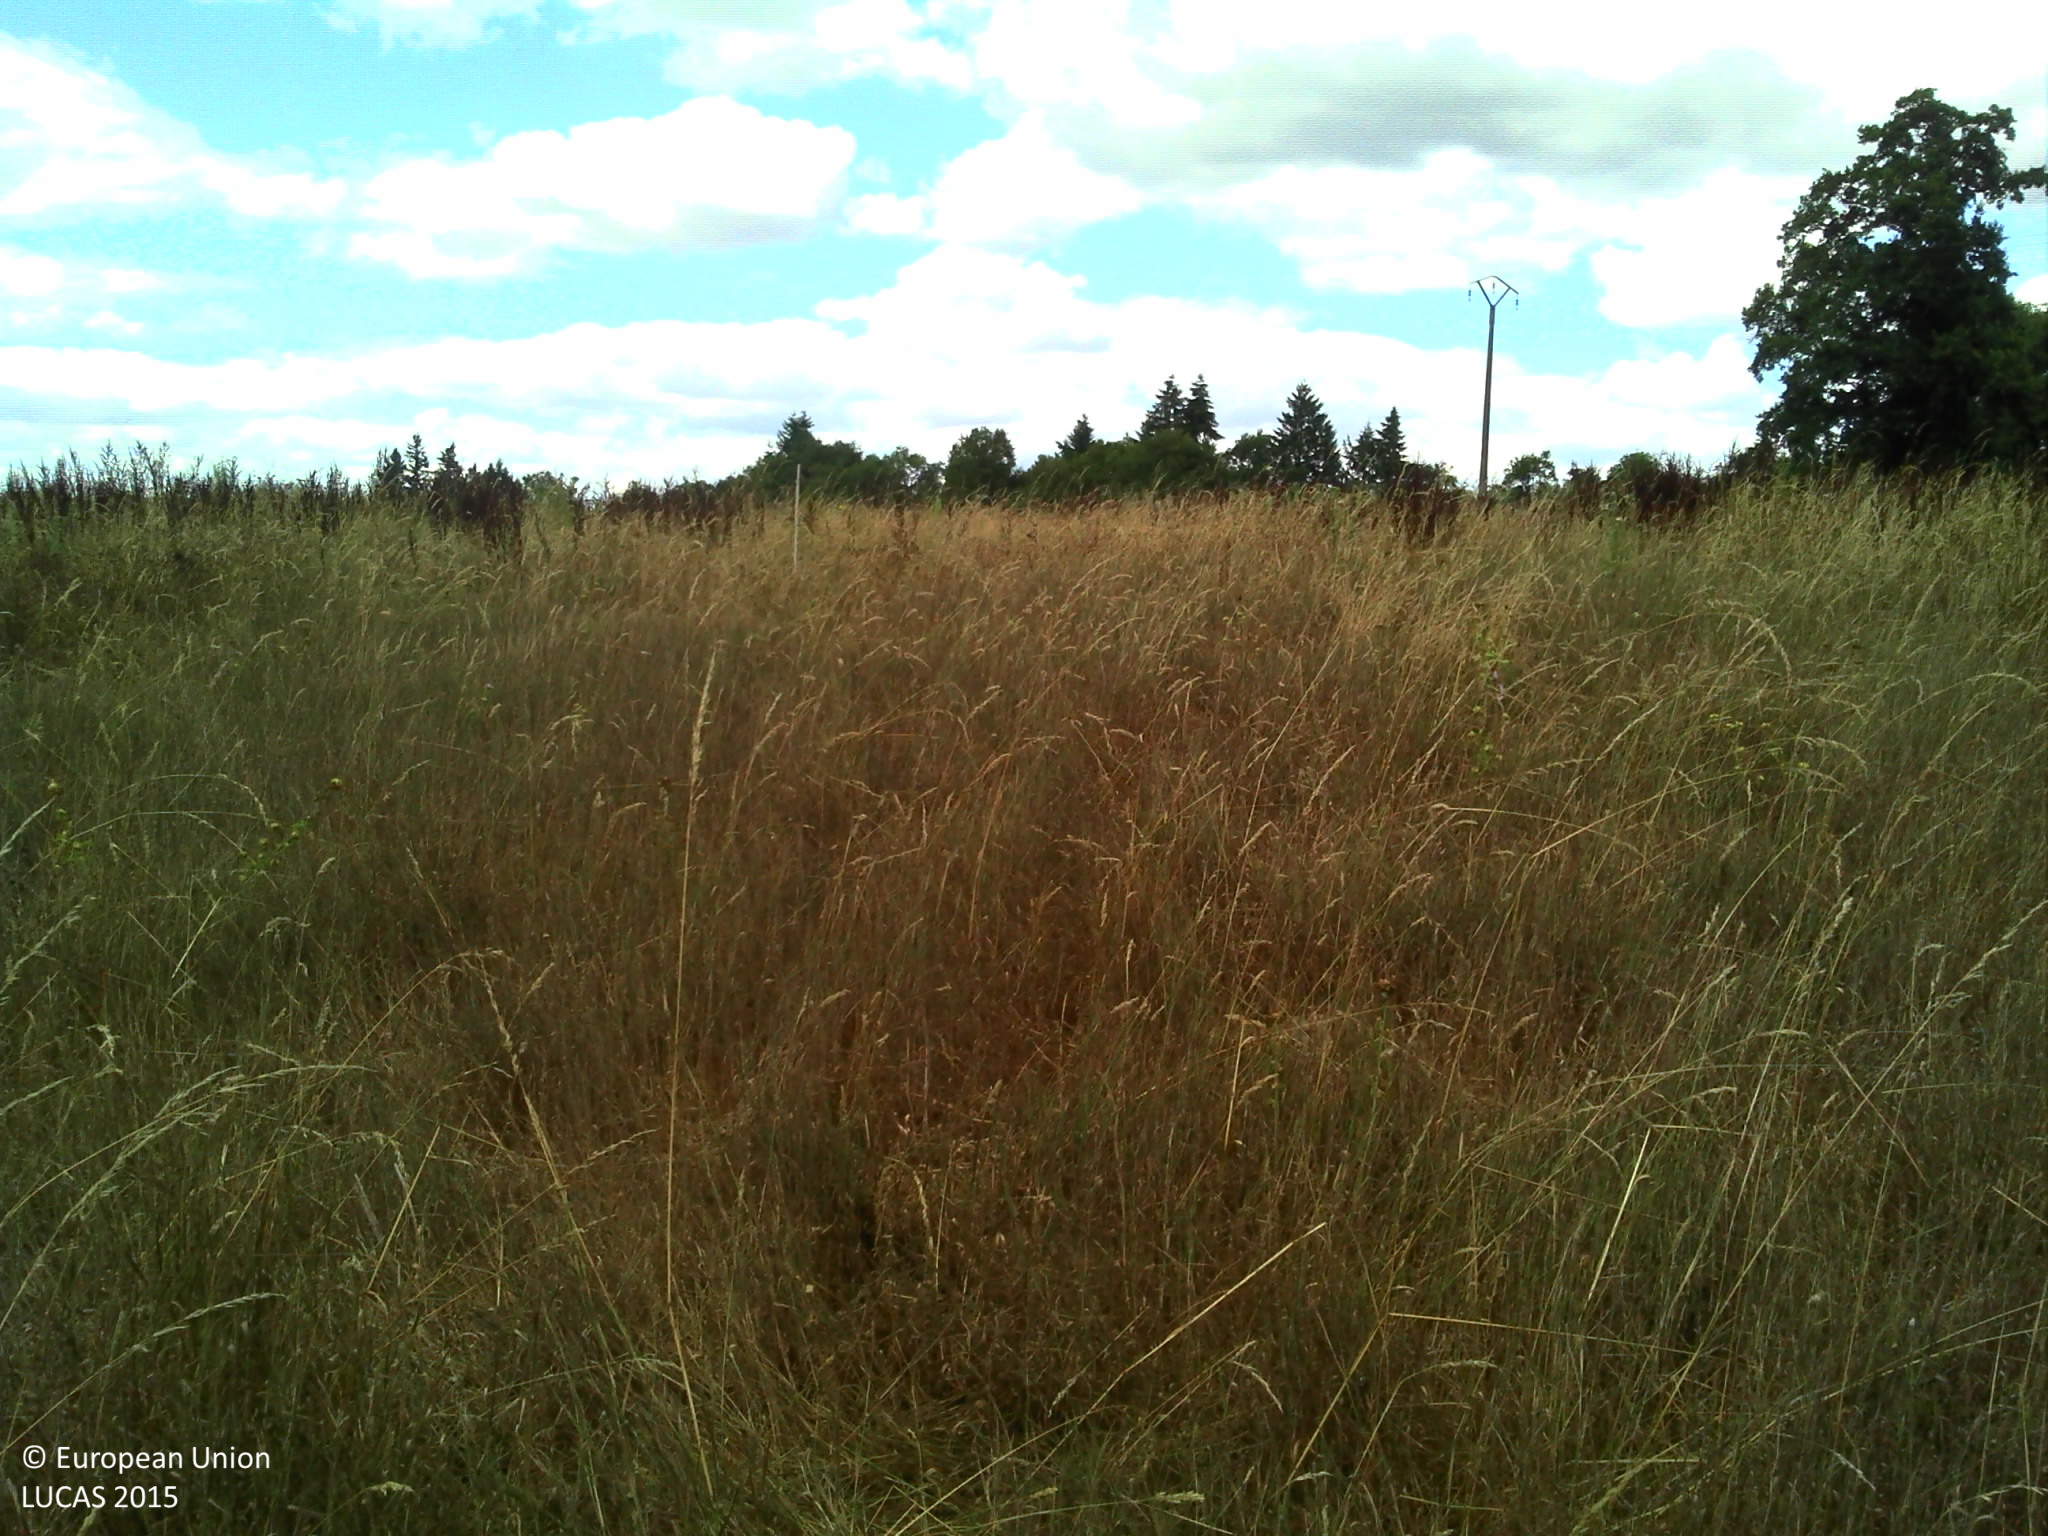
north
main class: Grassland
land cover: Grassland without tree/shrub cover
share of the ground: > 75 %
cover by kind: herbaceous plants 100 %
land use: Agriculture (excluding fallow land and kitchen gardens)
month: July
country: FR
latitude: 45.9327
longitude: 0.9736
